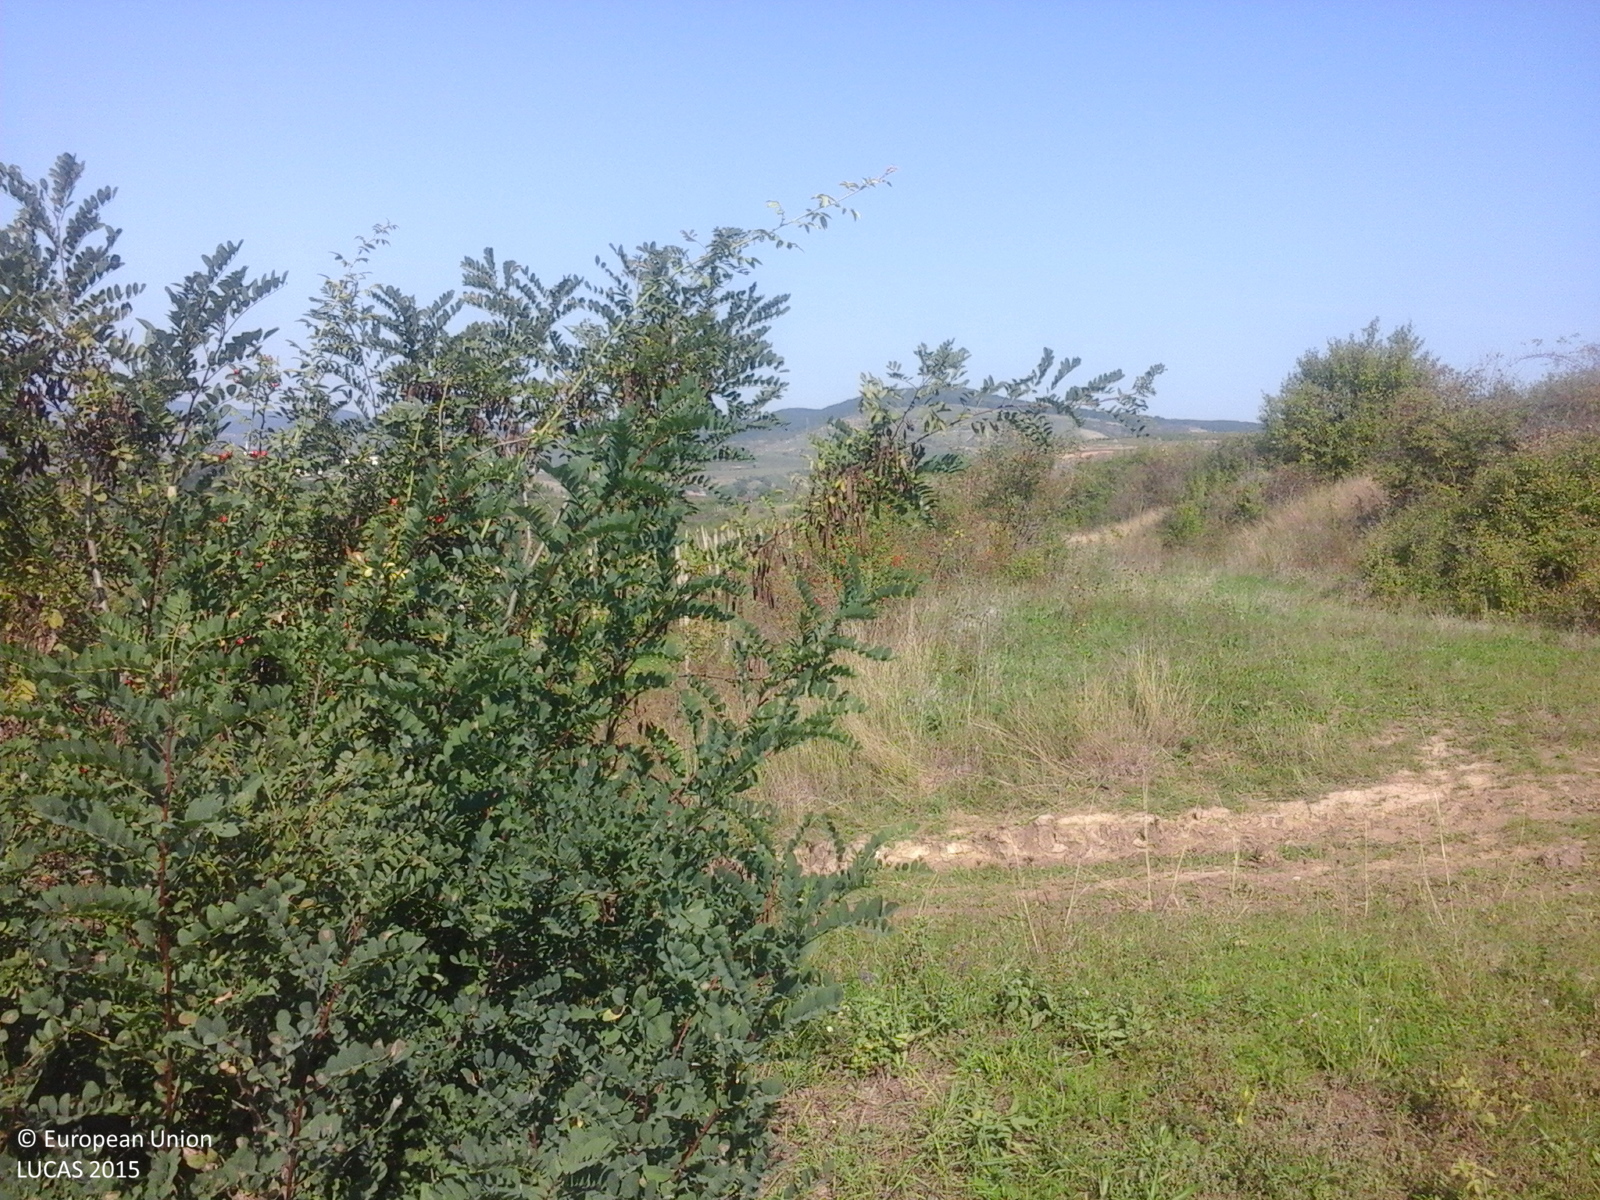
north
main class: Cropland
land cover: Vineyards
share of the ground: > 75 %
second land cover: Grassland without tree/shrub cover
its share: > 75 %
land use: Agriculture (excluding fallow land and kitchen gardens)
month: October
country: RO
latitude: 46.2959
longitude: 23.7670
